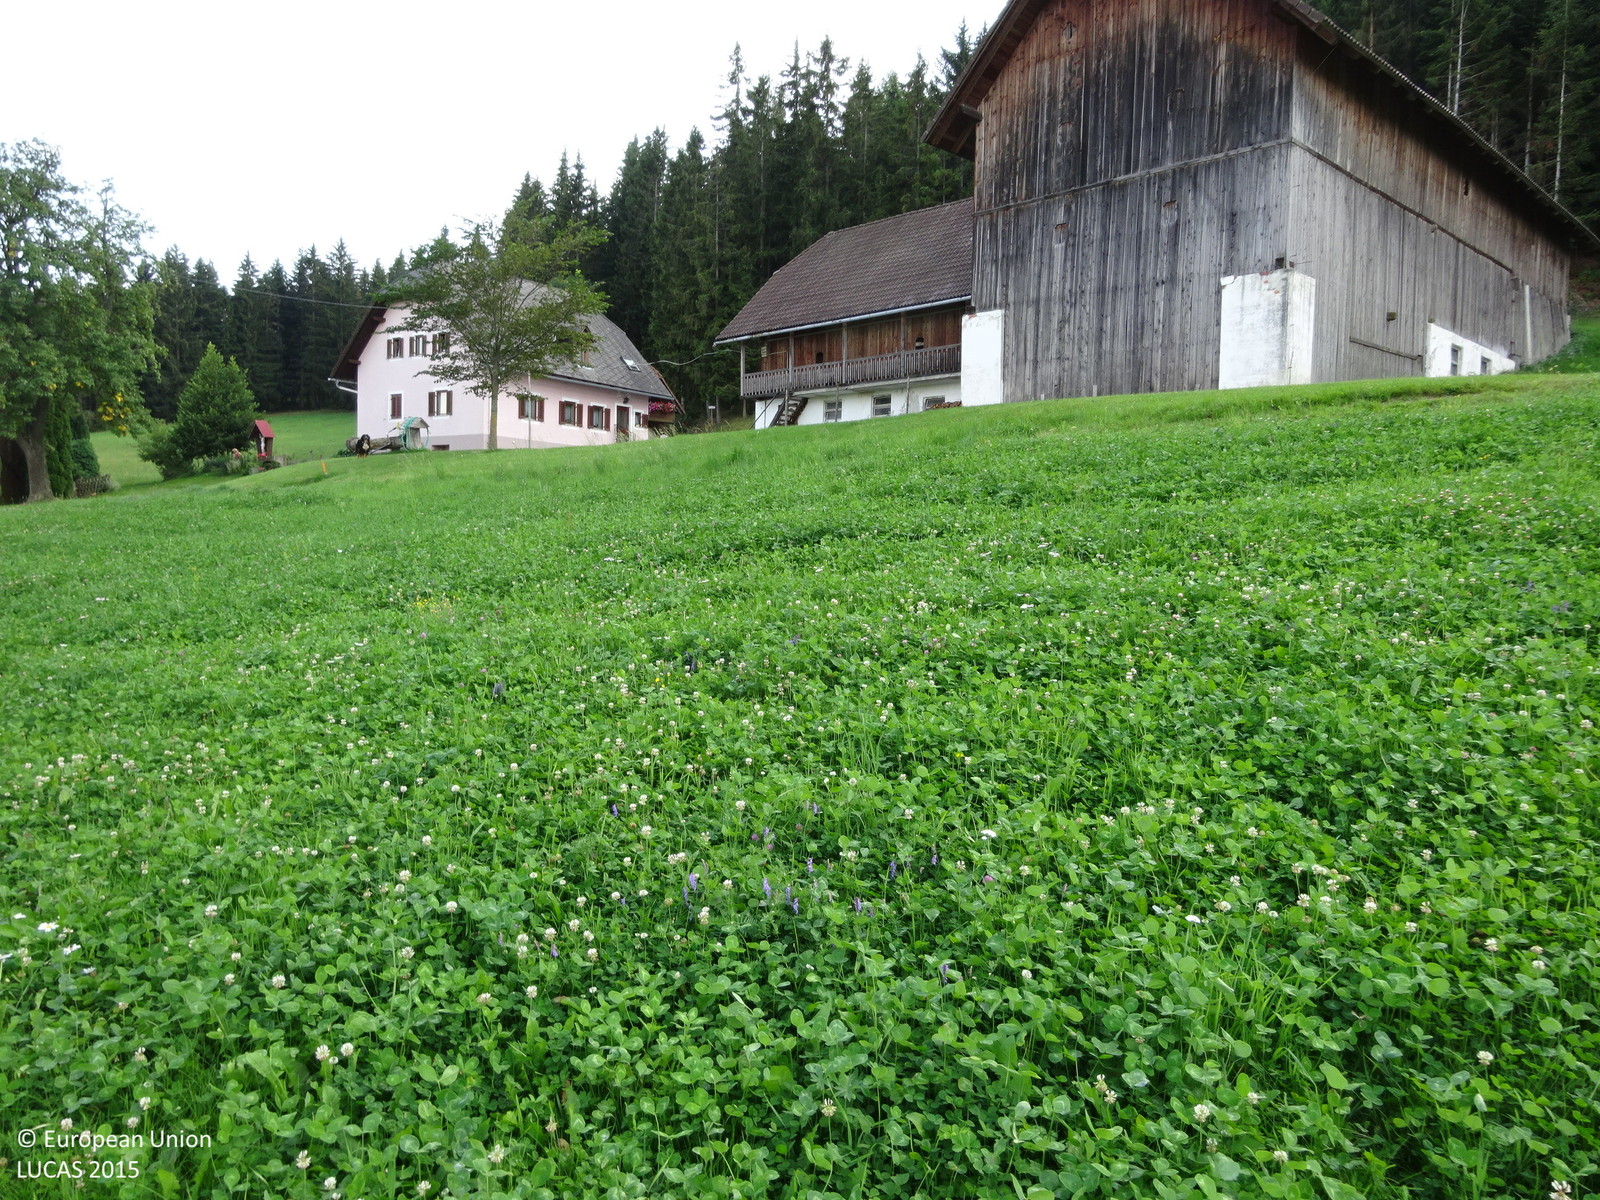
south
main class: Cropland
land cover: Clovers
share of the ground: > 75 %
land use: Agriculture (excluding fallow land and kitchen gardens)
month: August
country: AT
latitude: 47.4230
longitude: 15.7677
